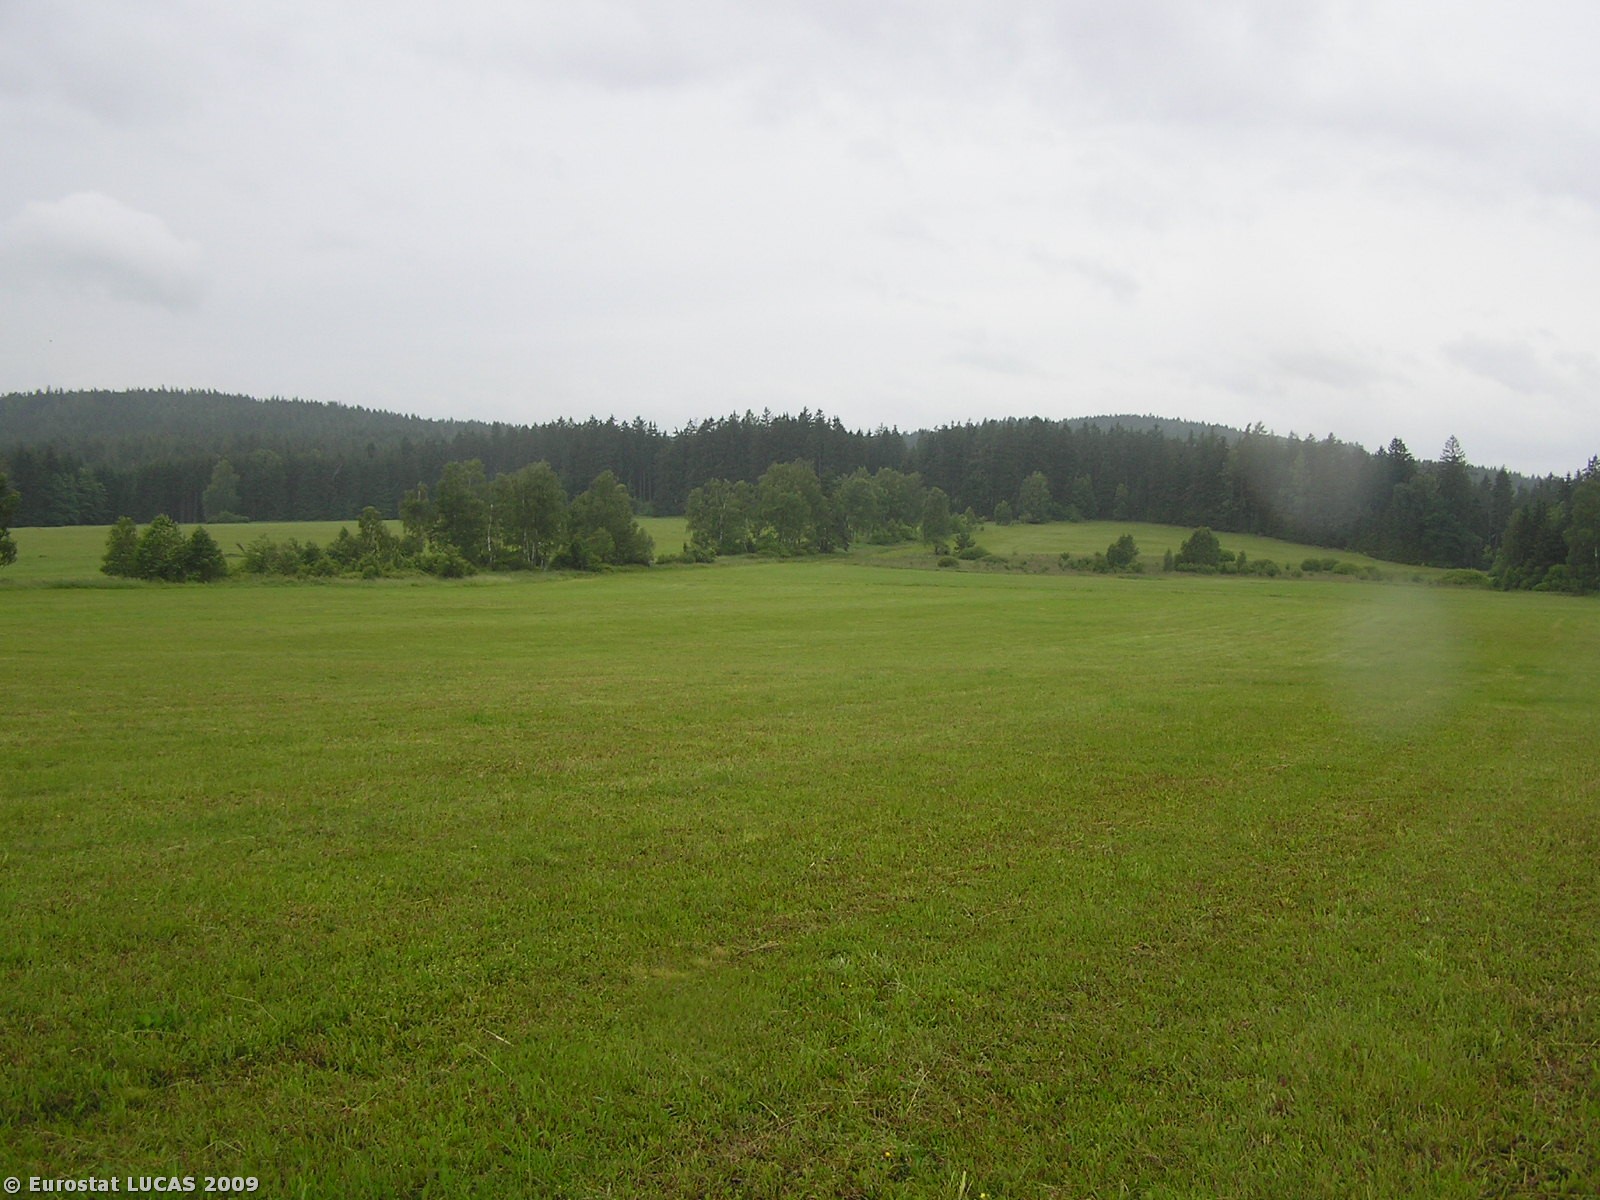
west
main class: Grassland
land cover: Grassland without tree/shrub cover
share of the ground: > 75 %
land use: Agriculture (excluding fallow land and kitchen gardens)
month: June
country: CZ
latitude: 49.2474
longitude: 14.9613
